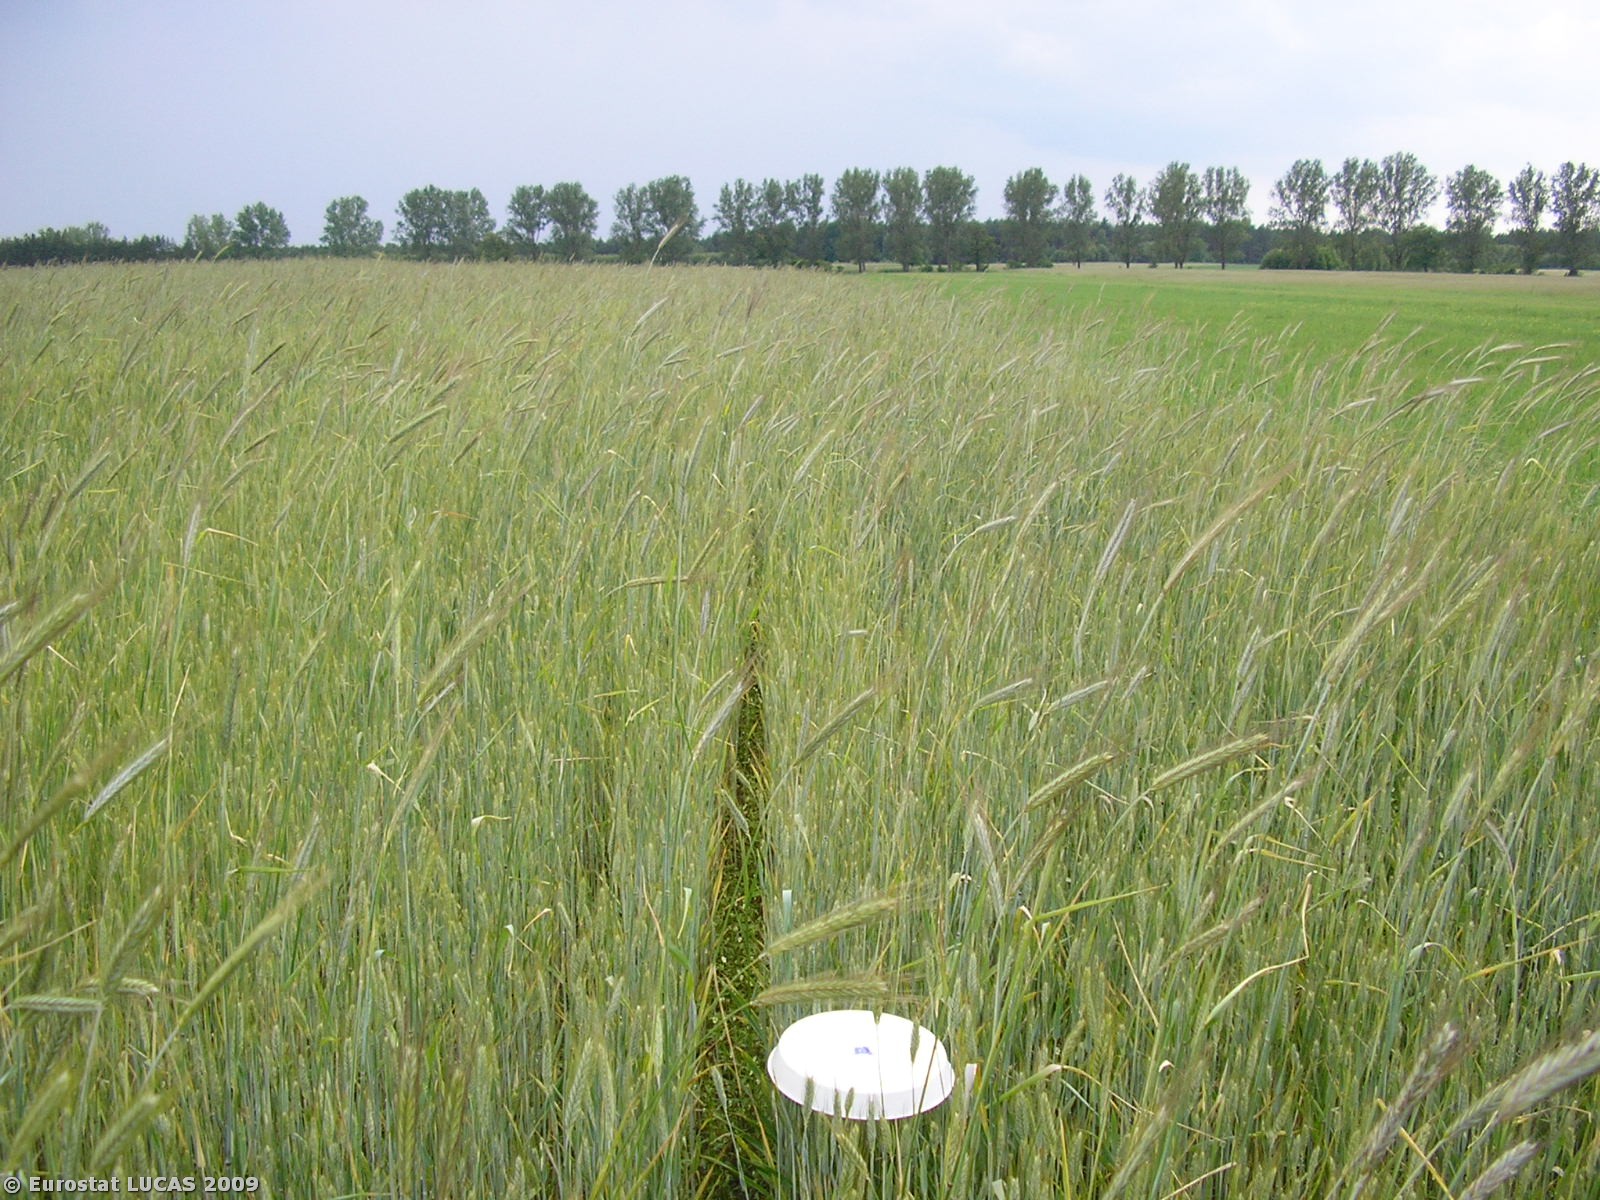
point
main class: Cropland
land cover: Triticale
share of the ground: 50 - 75 %
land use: Agriculture (excluding fallow land and kitchen gardens)
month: June
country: PL
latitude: 51.0849
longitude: 18.8878
